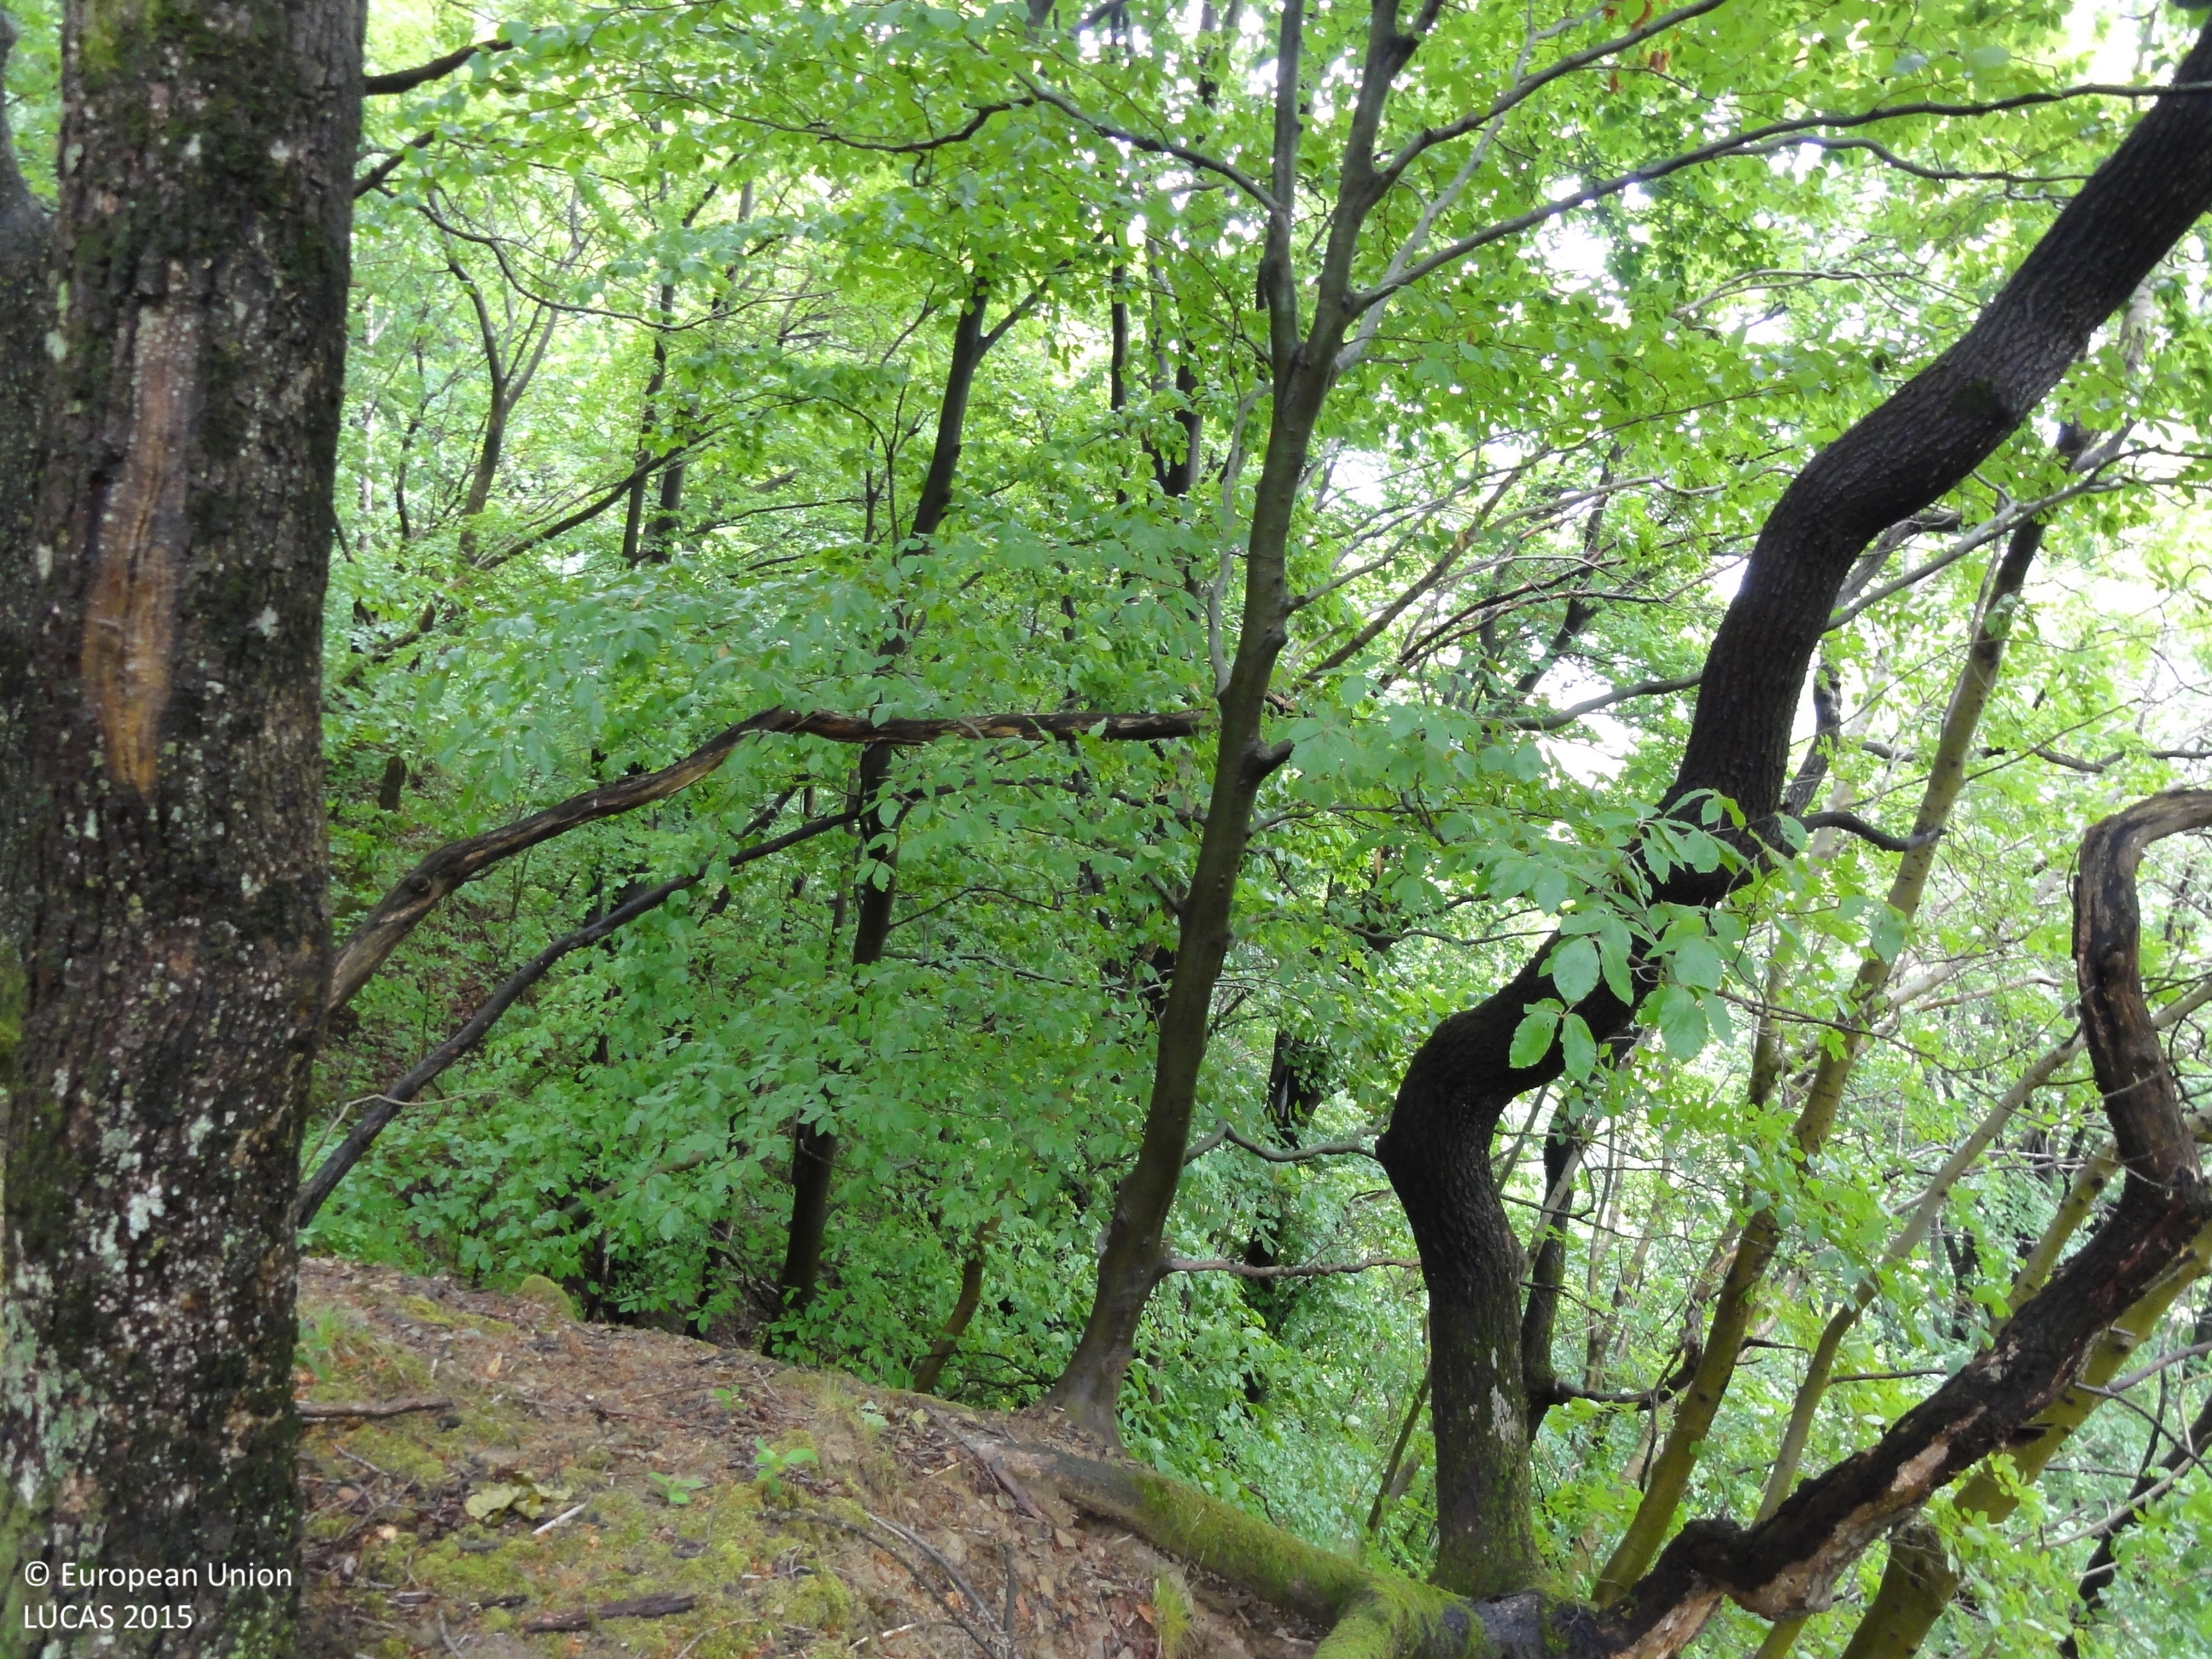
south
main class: Woodland
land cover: Broadleaved woodland
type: beech forest
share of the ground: > 75 %
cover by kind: broadleaved forest trees 95 %, herbaceous plants 5 %
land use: Semi-natural and natural areas not in use
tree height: > 5 m
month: May
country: SI
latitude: 46.5410
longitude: 15.7238
